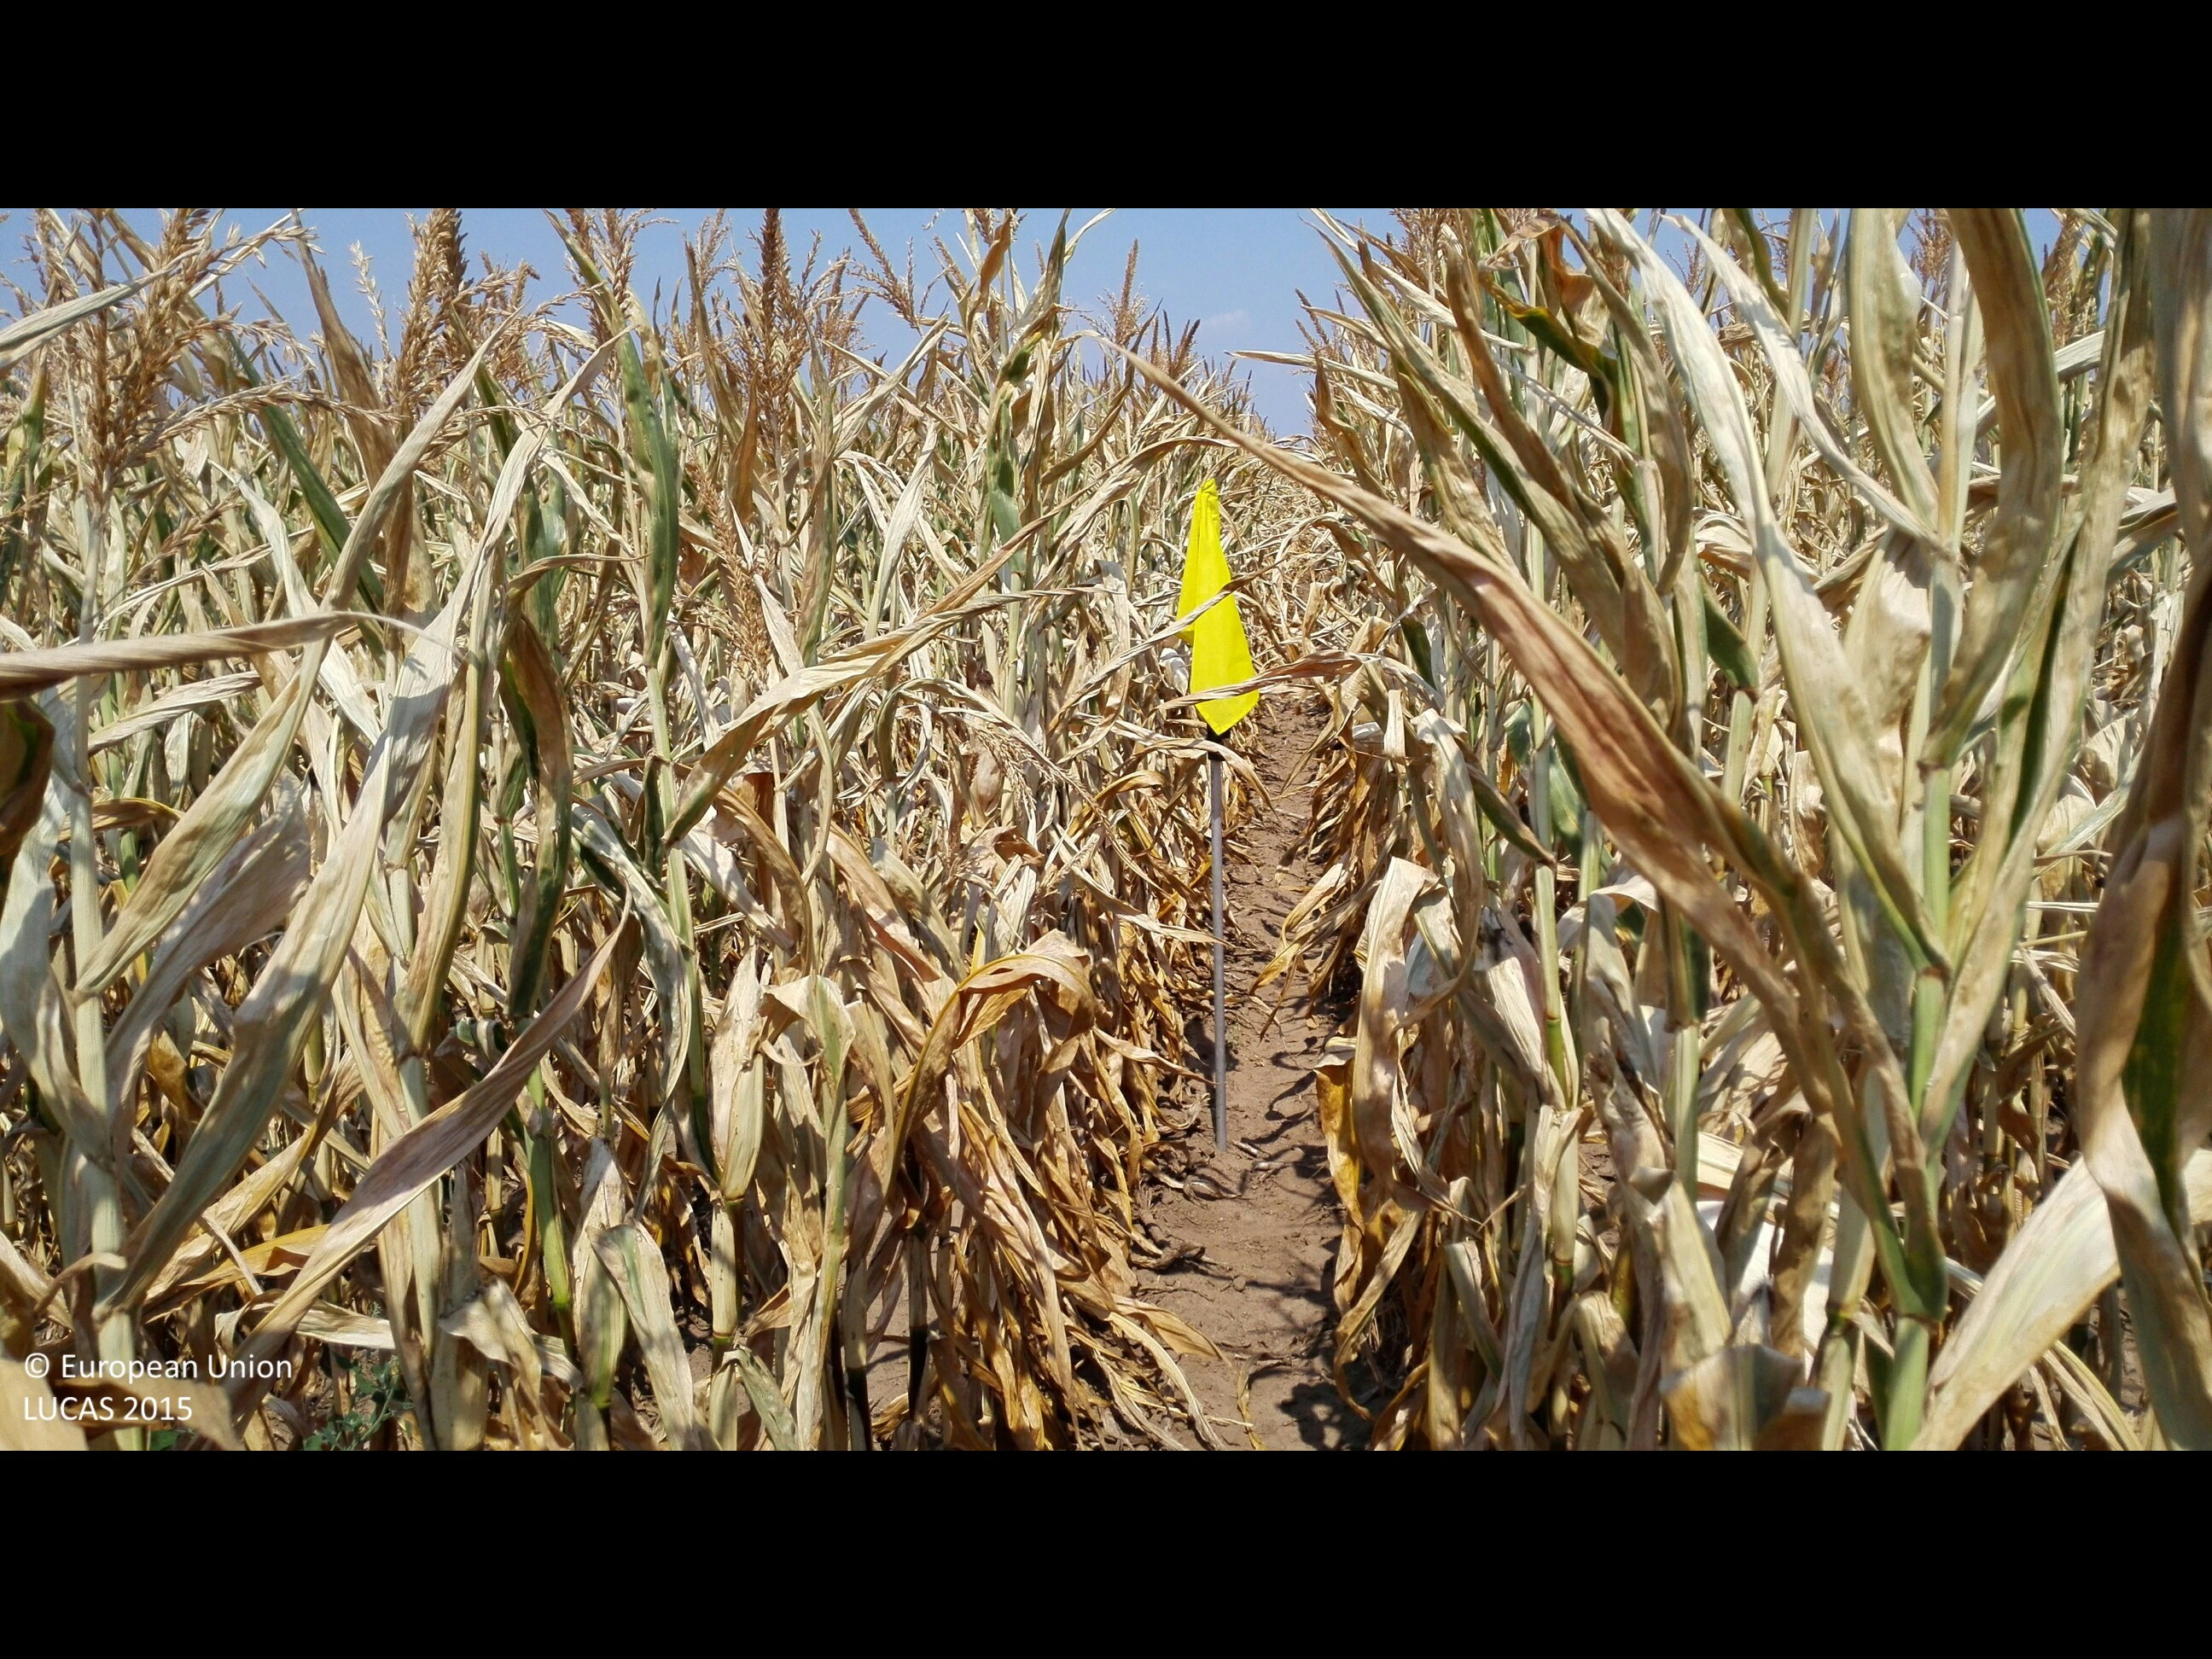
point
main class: Cropland
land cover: Maize
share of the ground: > 75 %
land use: Agriculture (excluding fallow land and kitchen gardens)
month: August
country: HU
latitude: 47.4075
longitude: 21.6129
